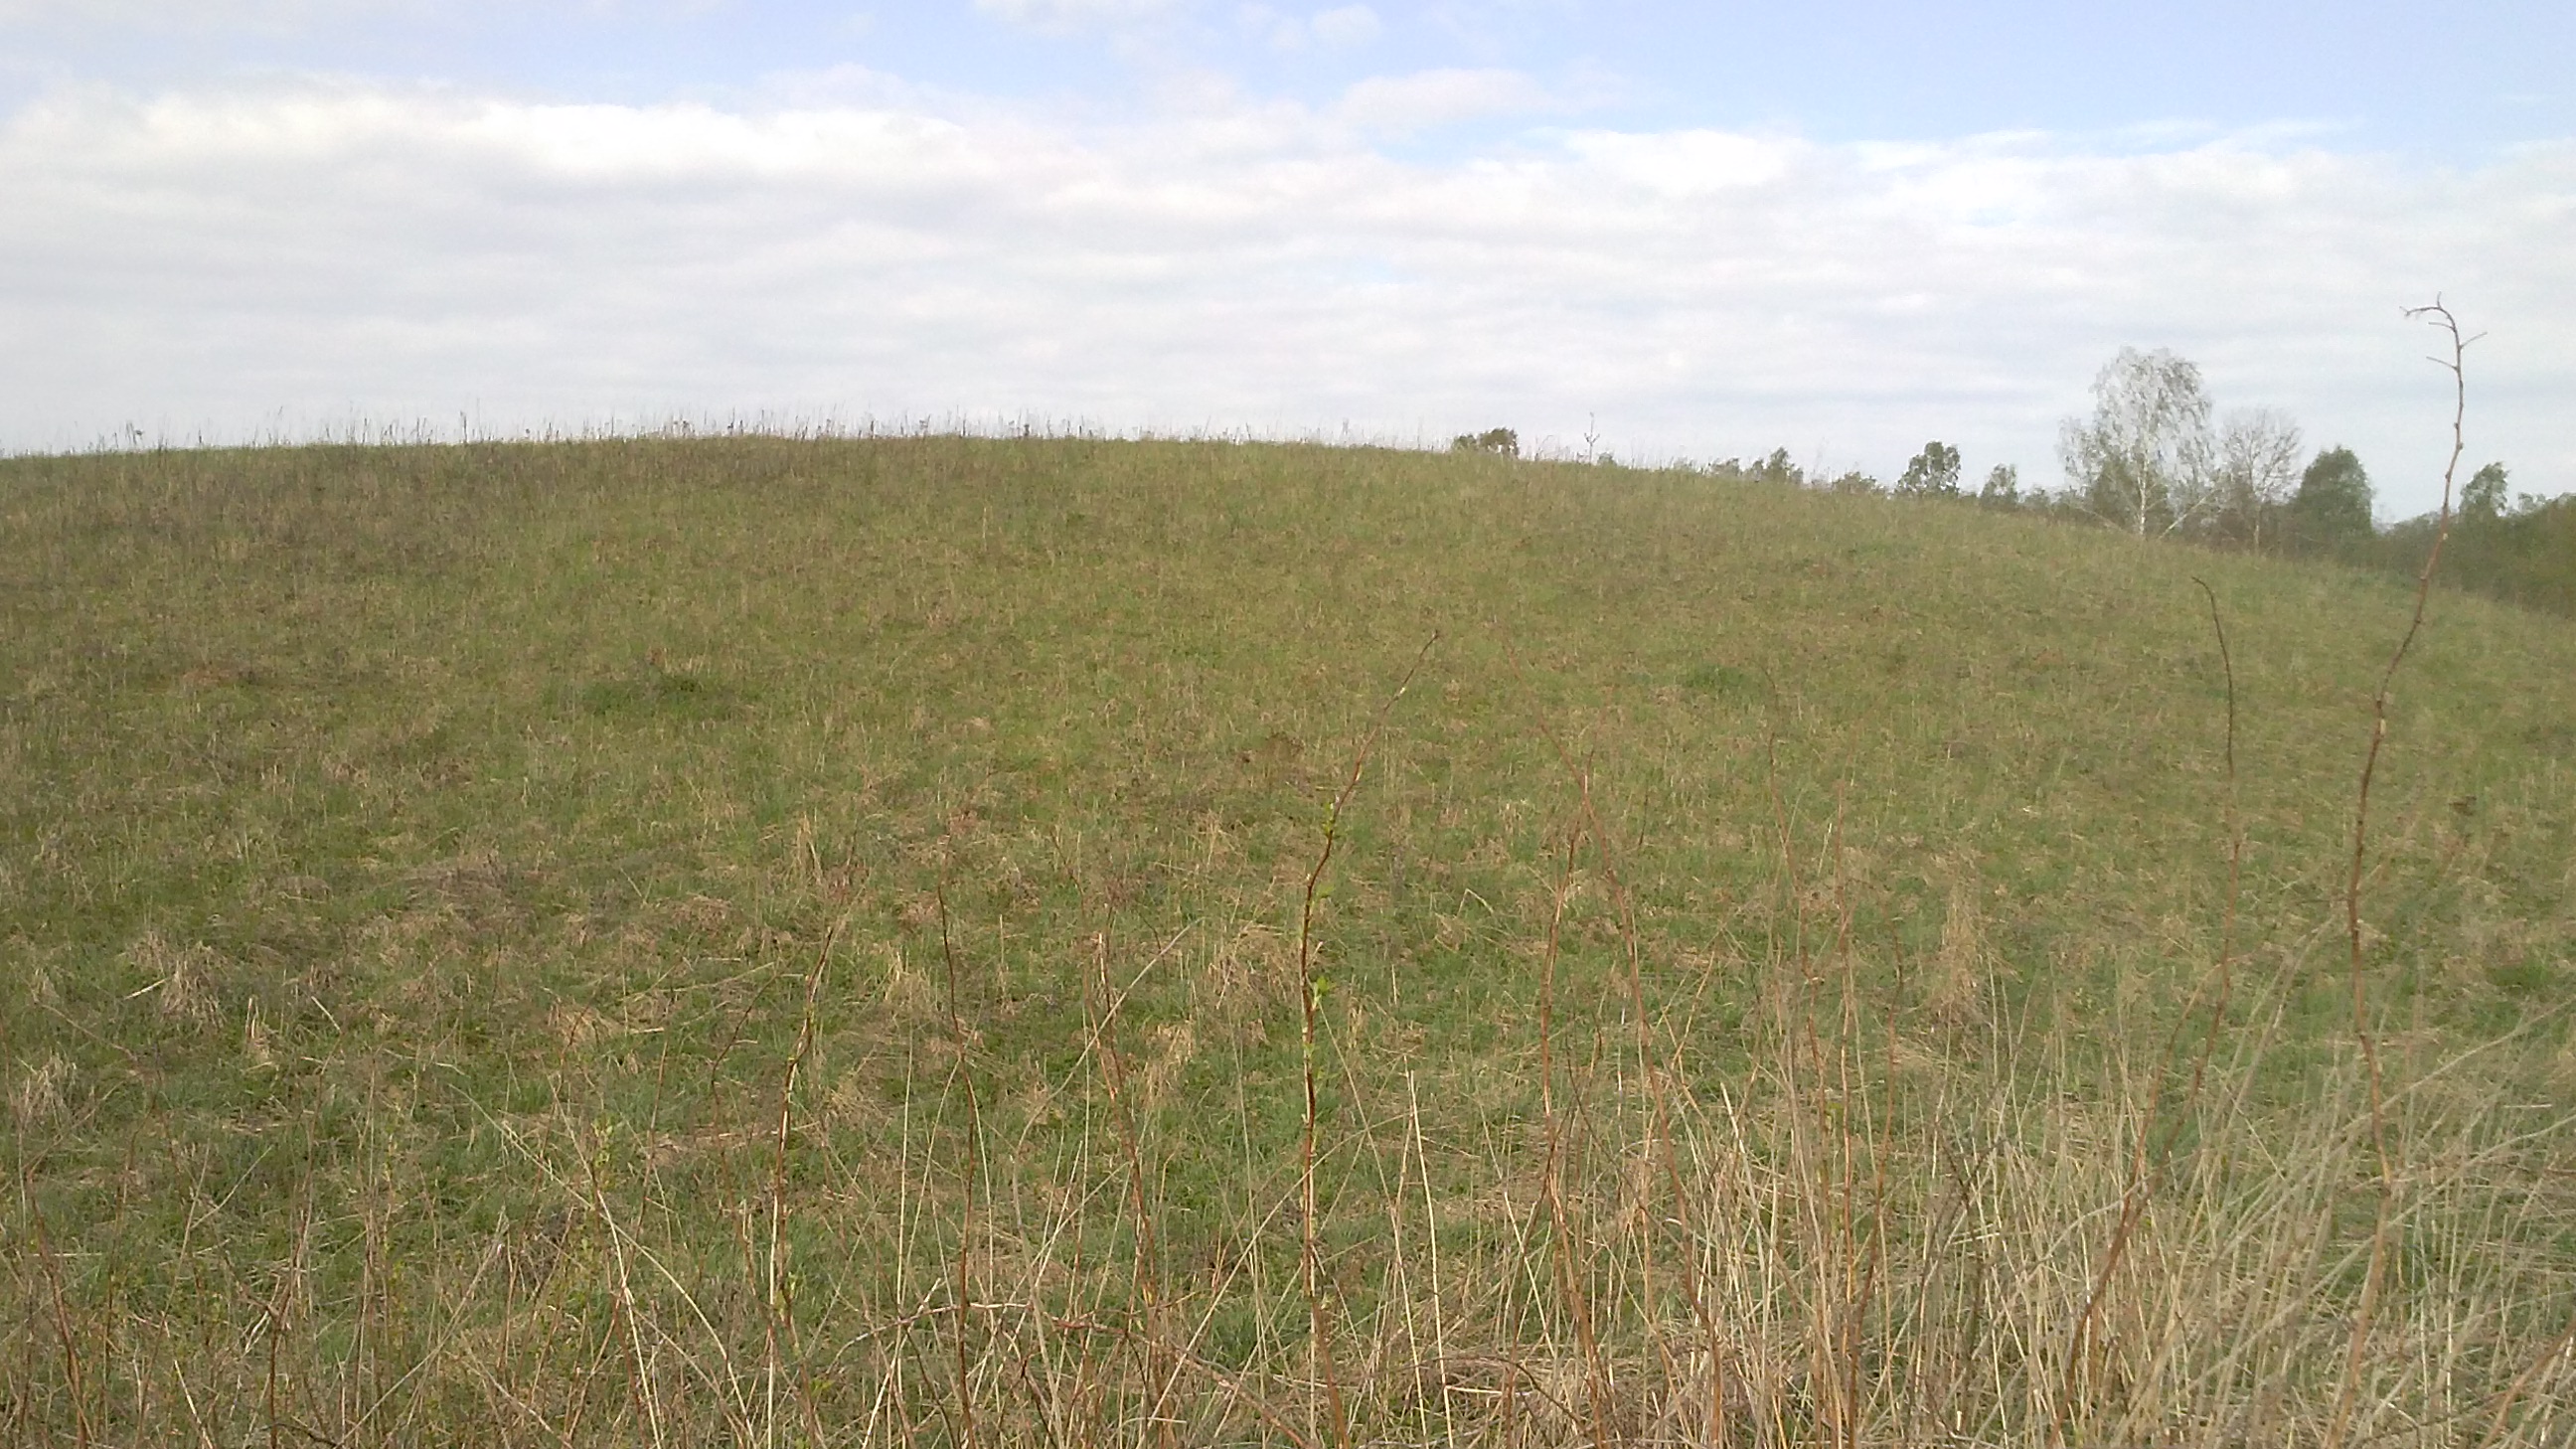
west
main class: Woodland
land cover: Broadleaved woodland
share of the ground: 10 - 25 %
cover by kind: herbaceous plants 80 %, broadleaved forest trees 20 %
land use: Semi-natural and natural areas not in use
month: May
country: LV
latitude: 55.9142
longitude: 27.0795
